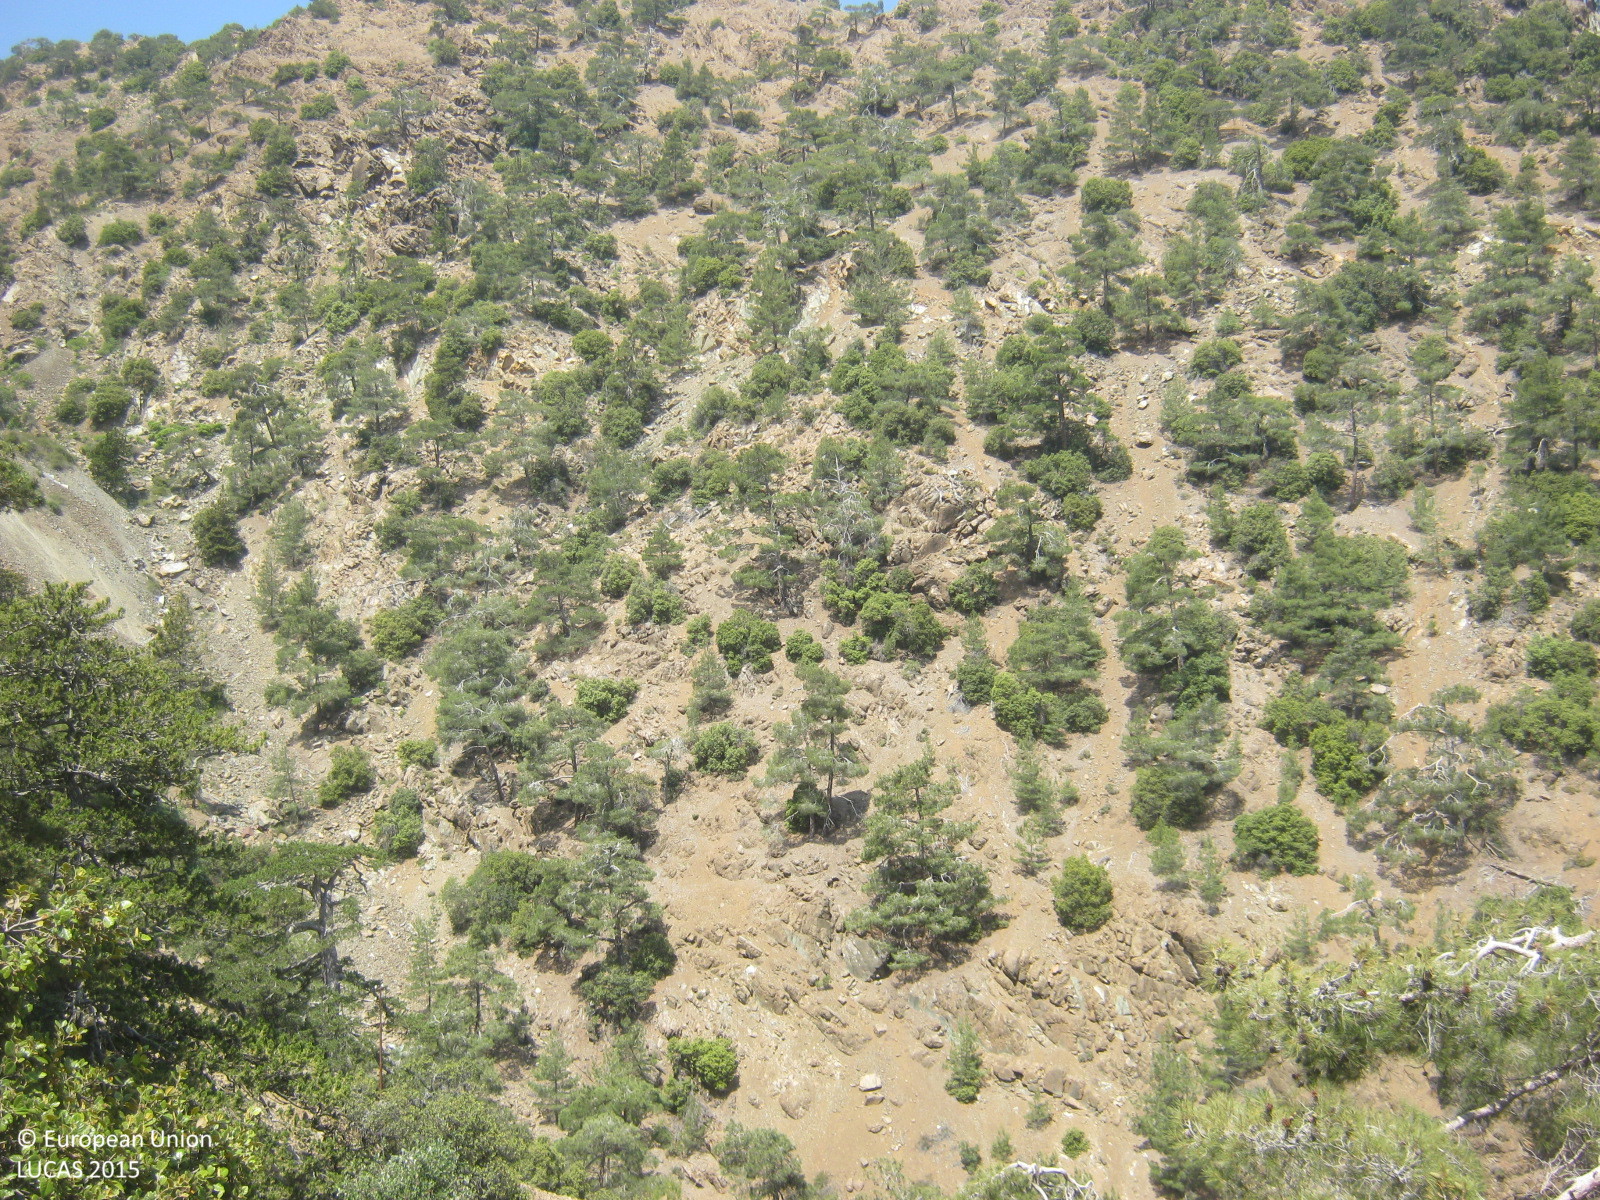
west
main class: Woodland
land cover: Pine dominated coniferous woodland
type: coniferous forest of the mediterranean region
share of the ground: 10 - 25 %
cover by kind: unconsolidated bare surface 65 %, coniferous forest trees 15 %, shrubs 10 %, consolidated bare surface 10 %
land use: Forestry
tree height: > 5 m
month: June
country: CY
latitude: 34.9585
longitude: 32.8693
